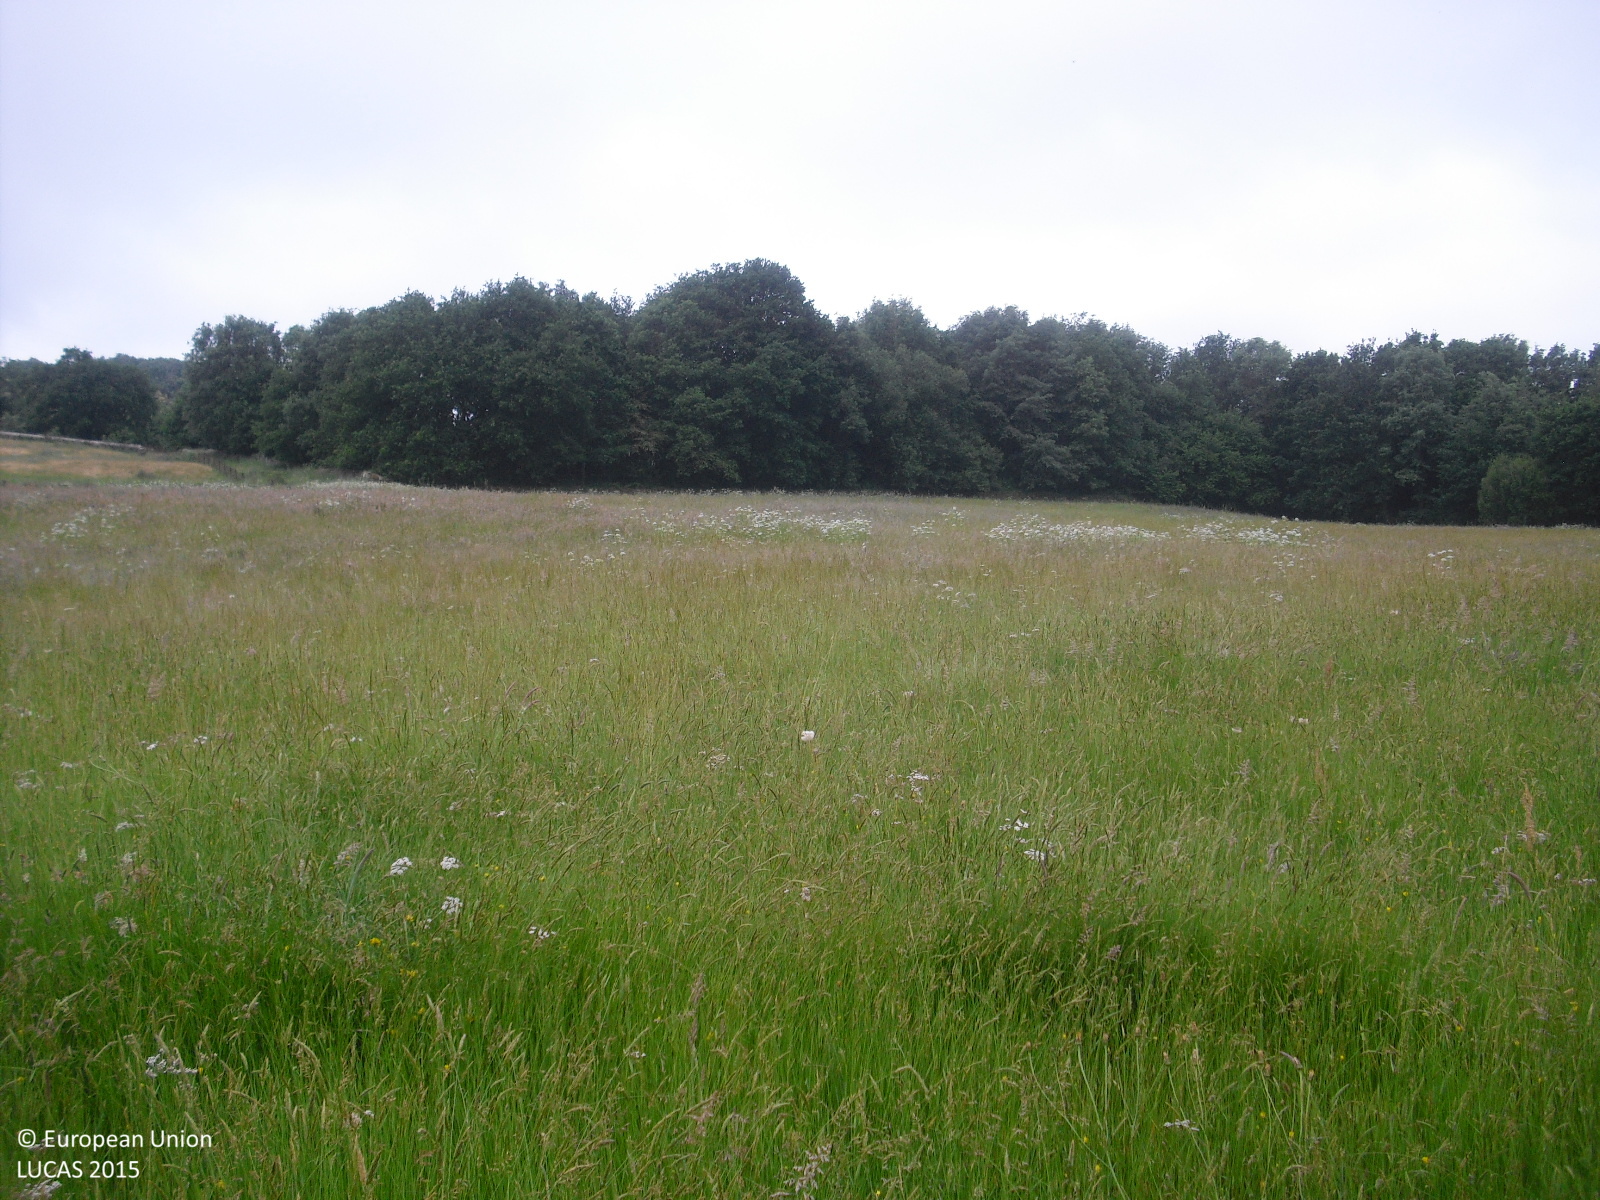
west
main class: Grassland
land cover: Grassland without tree/shrub cover
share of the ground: > 75 %
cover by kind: herbaceous plants 100 %
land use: Agriculture (excluding fallow land and kitchen gardens)
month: May
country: ES
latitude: 42.1940
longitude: -7.7645
